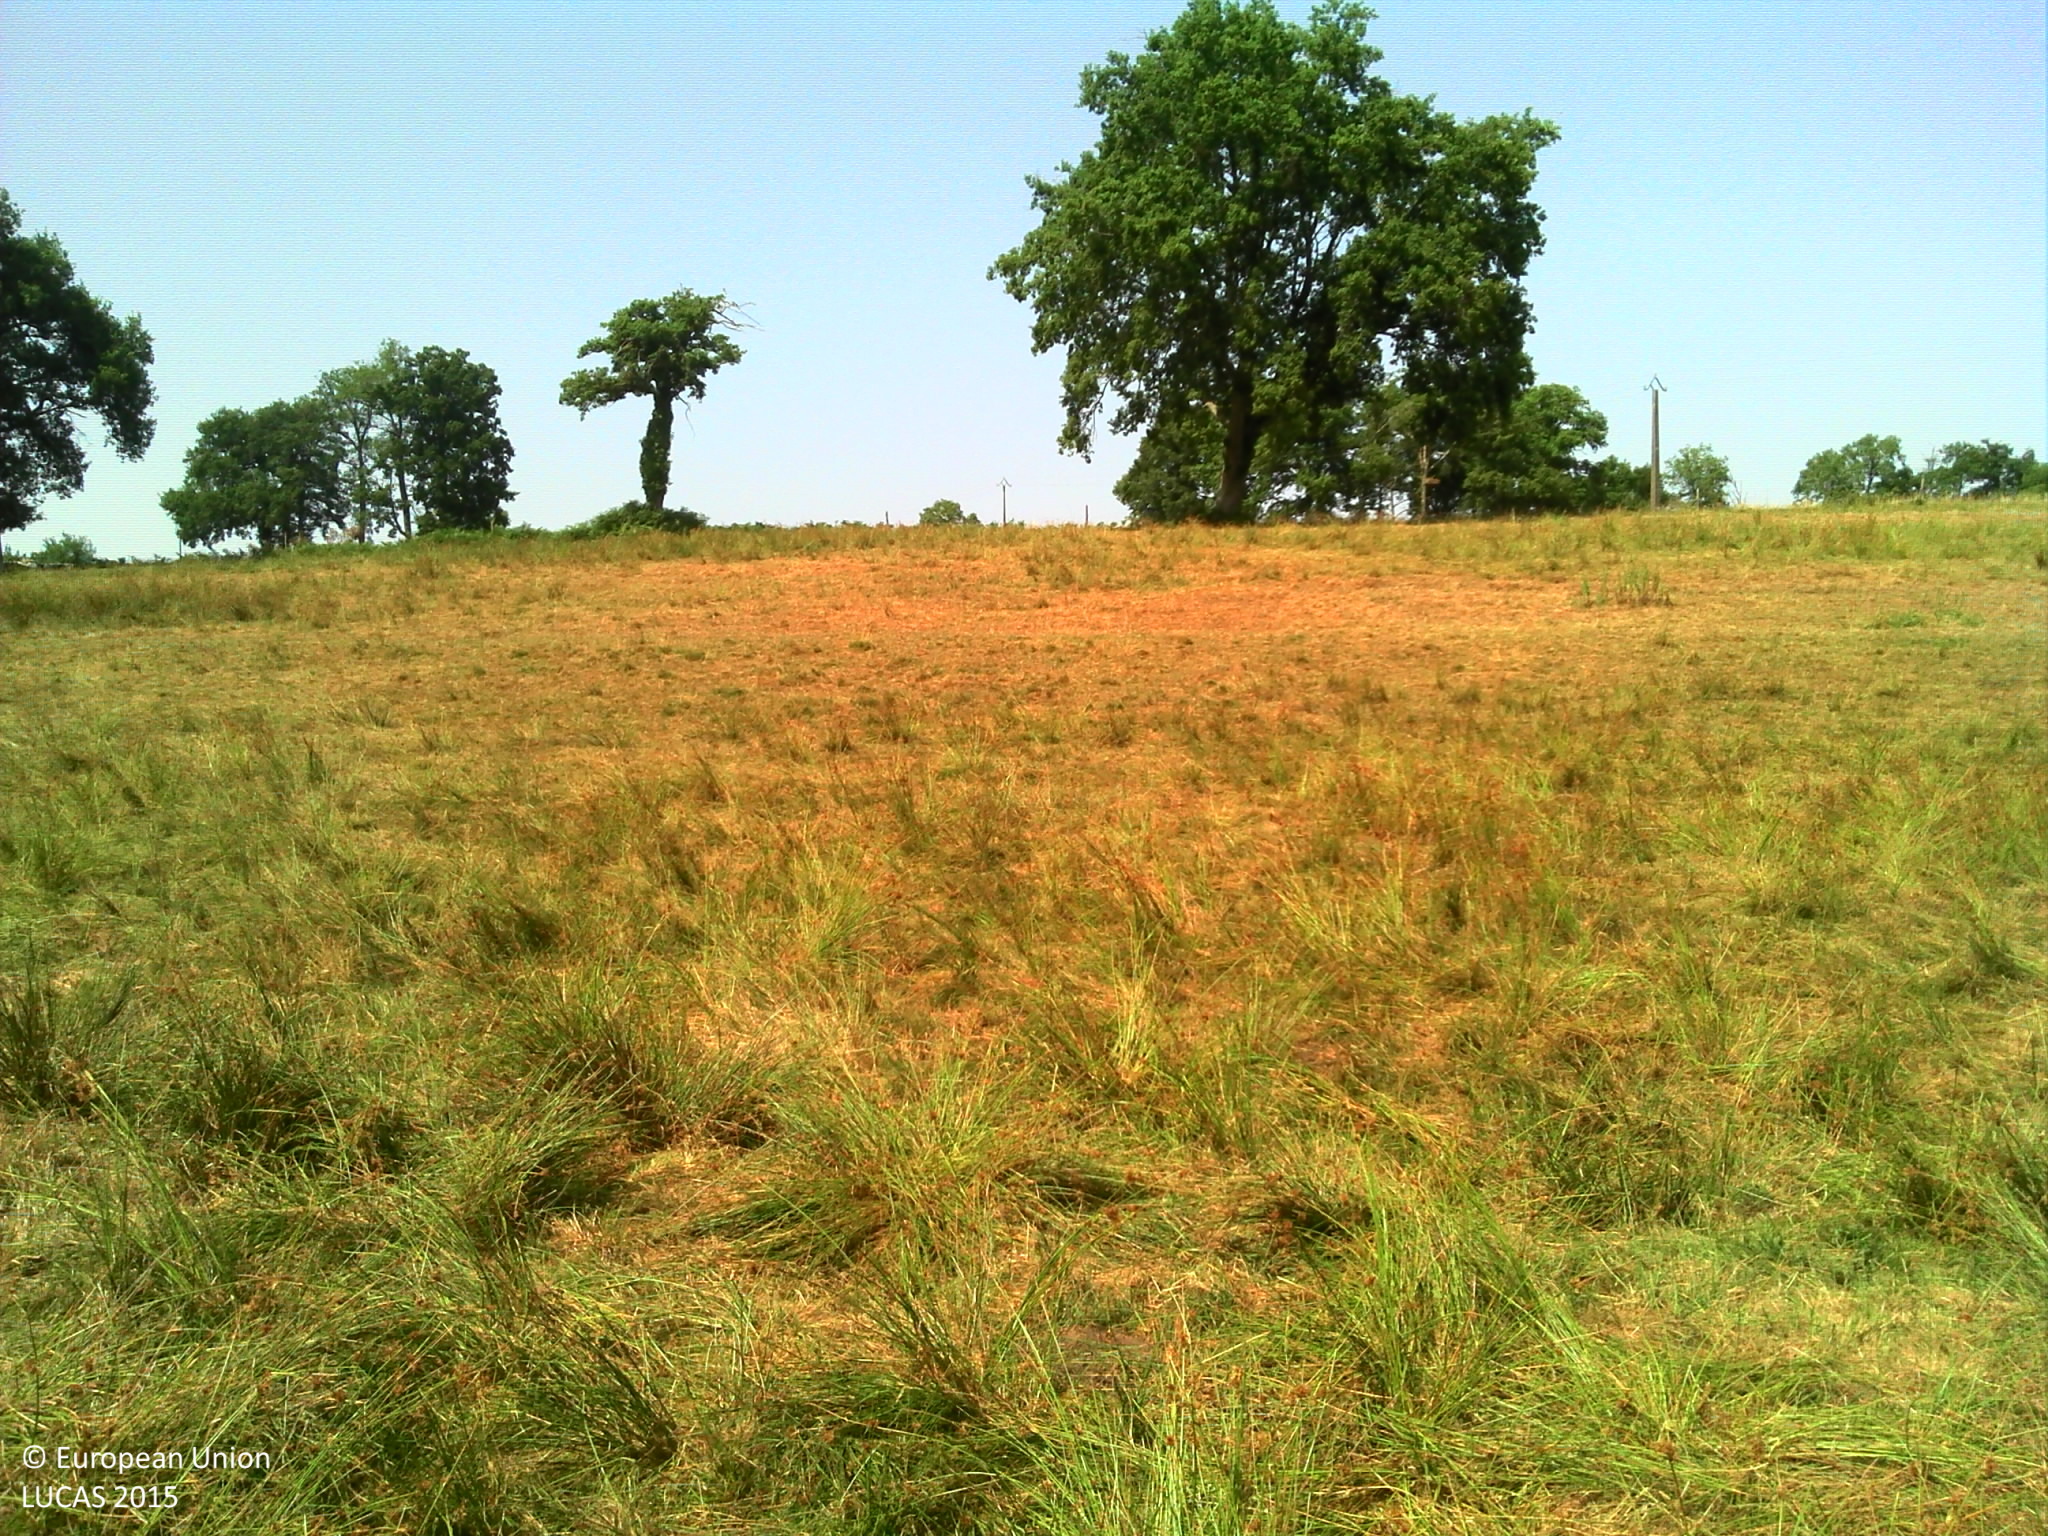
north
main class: Grassland
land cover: Grassland without tree/shrub cover
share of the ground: > 75 %
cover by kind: herbaceous plants 90 %, unconsolidated bare surface 5 %
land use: Agriculture (excluding fallow land and kitchen gardens)
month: July
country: FR
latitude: 45.7562
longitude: 1.0289
